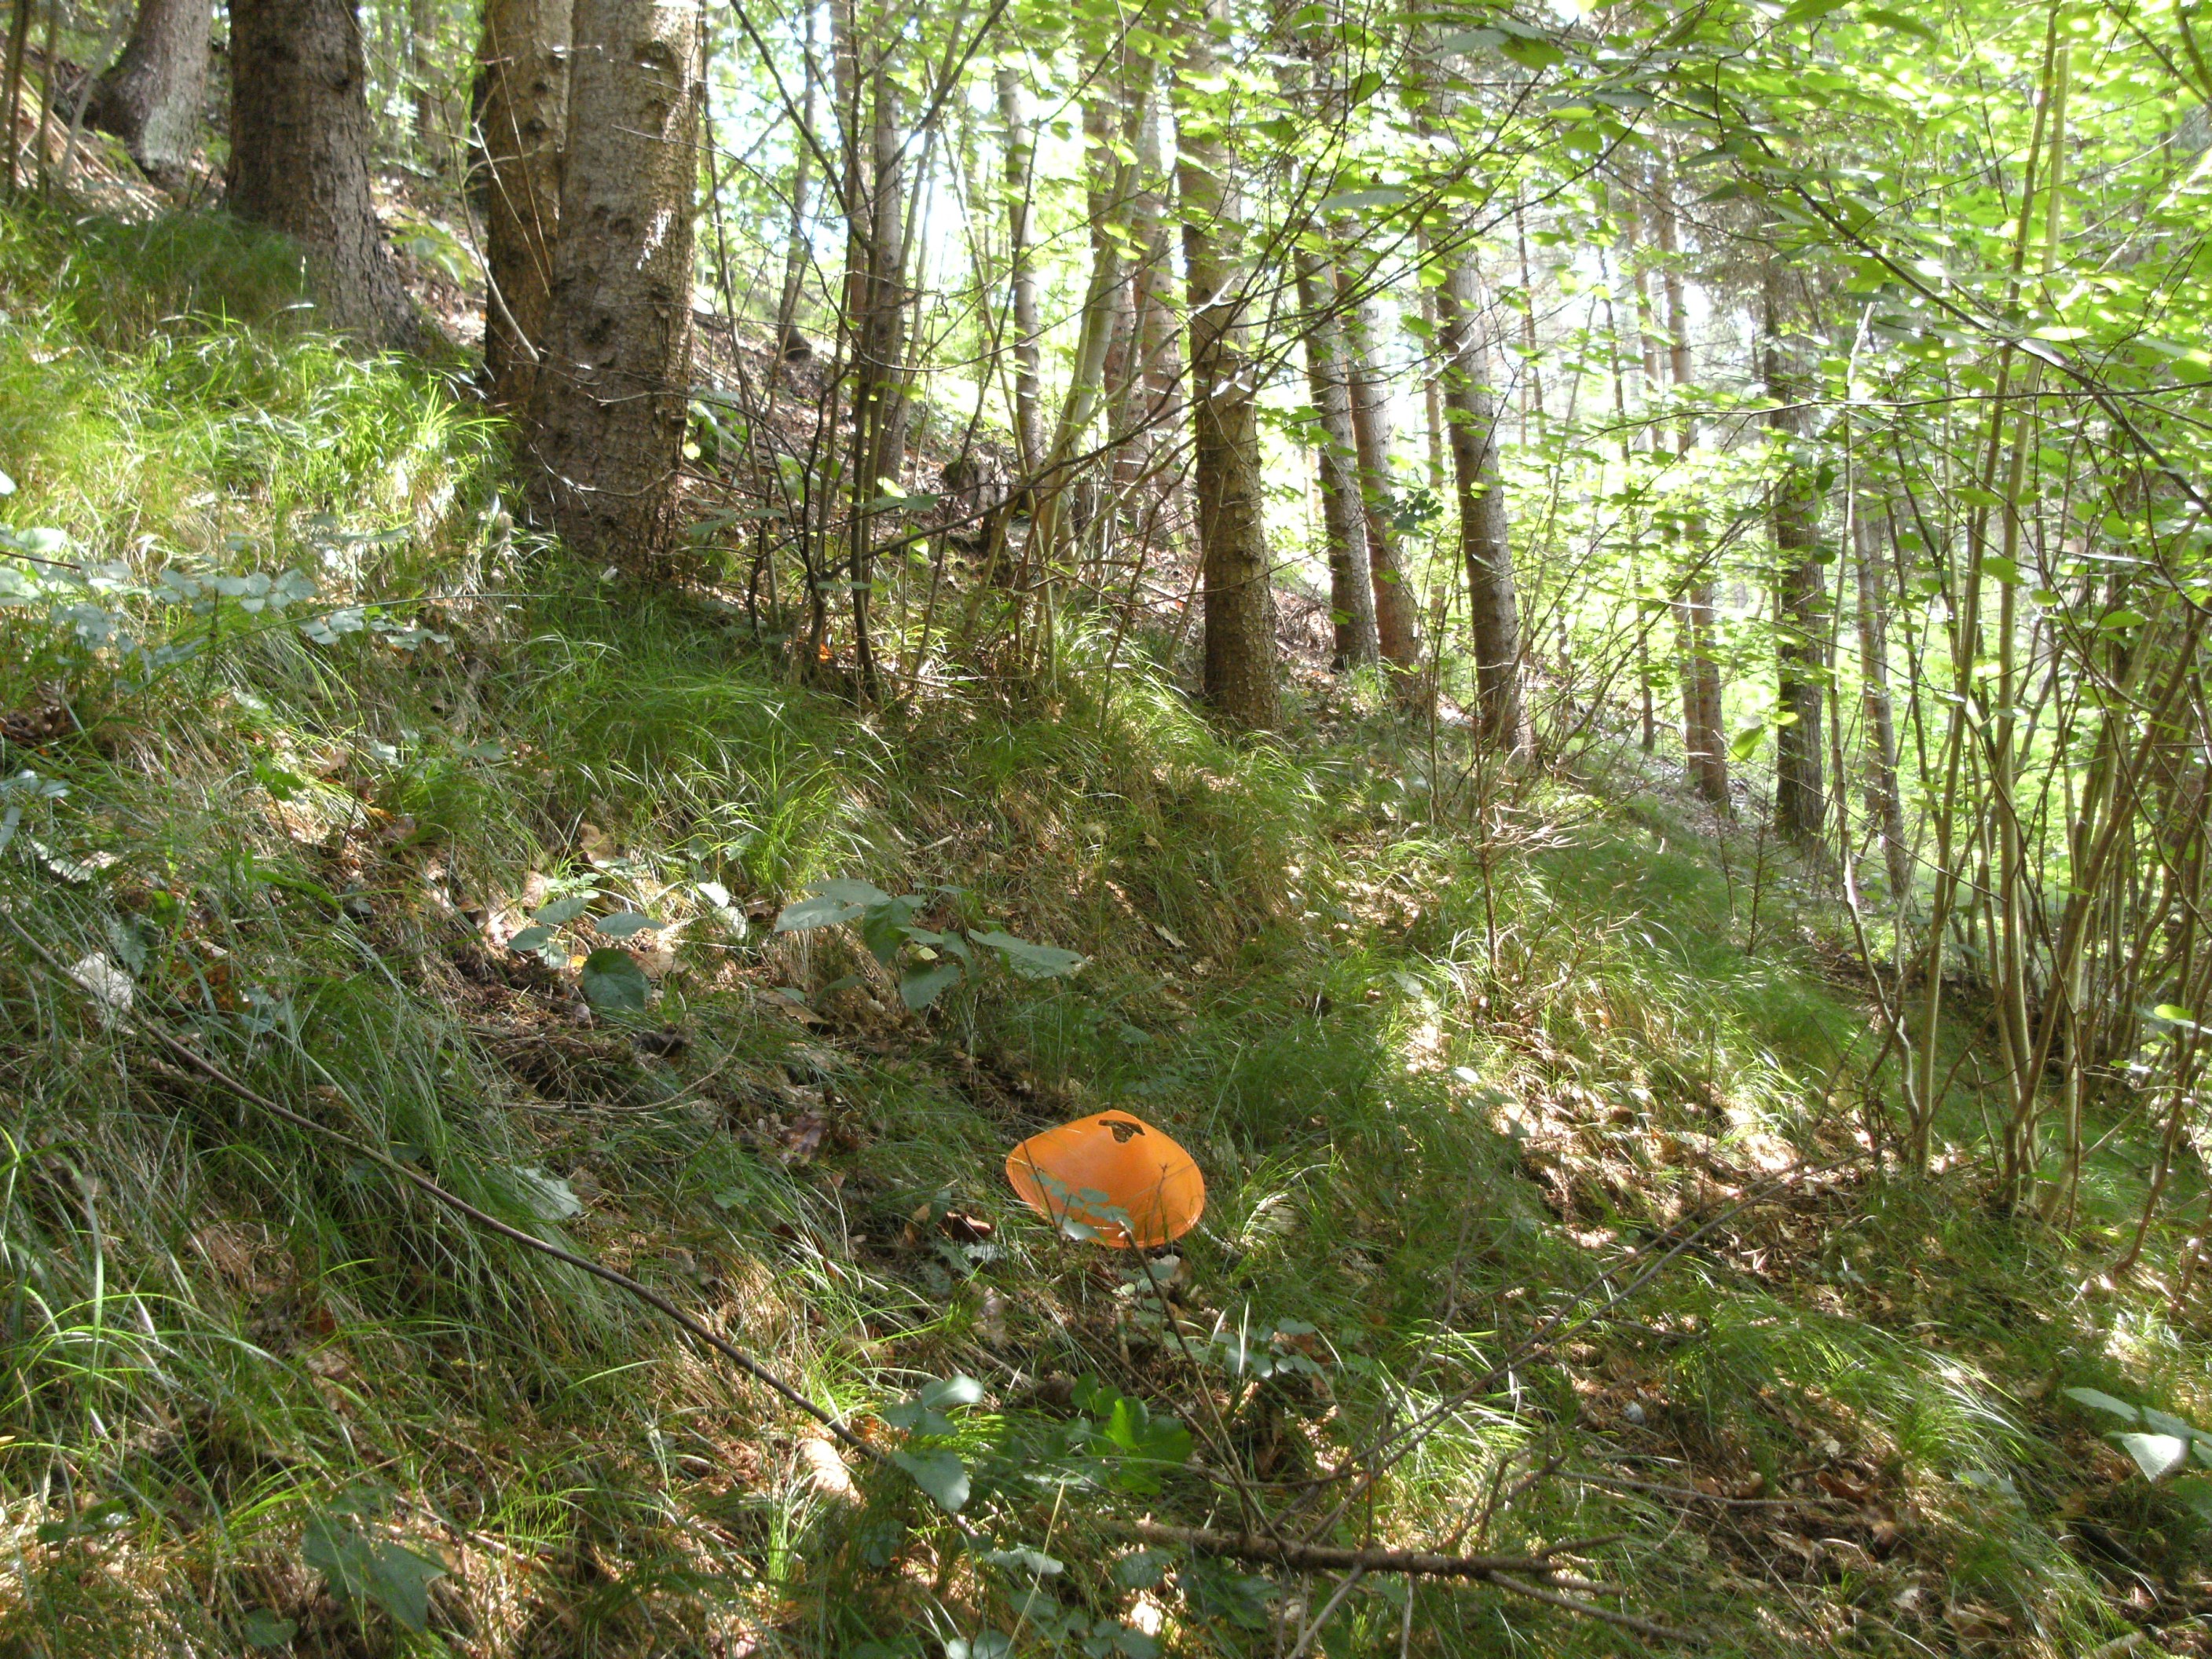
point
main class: Woodland
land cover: Spruce dominated coniferous woodland
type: hemiboreal forest and nemoral coniferous forest and mixed broadleaved-coniferous forest
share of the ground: 50 - 75 %
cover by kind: coniferous forest trees 60 %, shrubs 20 %, broadleaved forest trees 10 %, herbaceous plants 5 %, unconsolidated bare surface 5 %
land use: Forestry
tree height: > 5 m
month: July
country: AT
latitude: 46.6540
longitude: 14.8983
